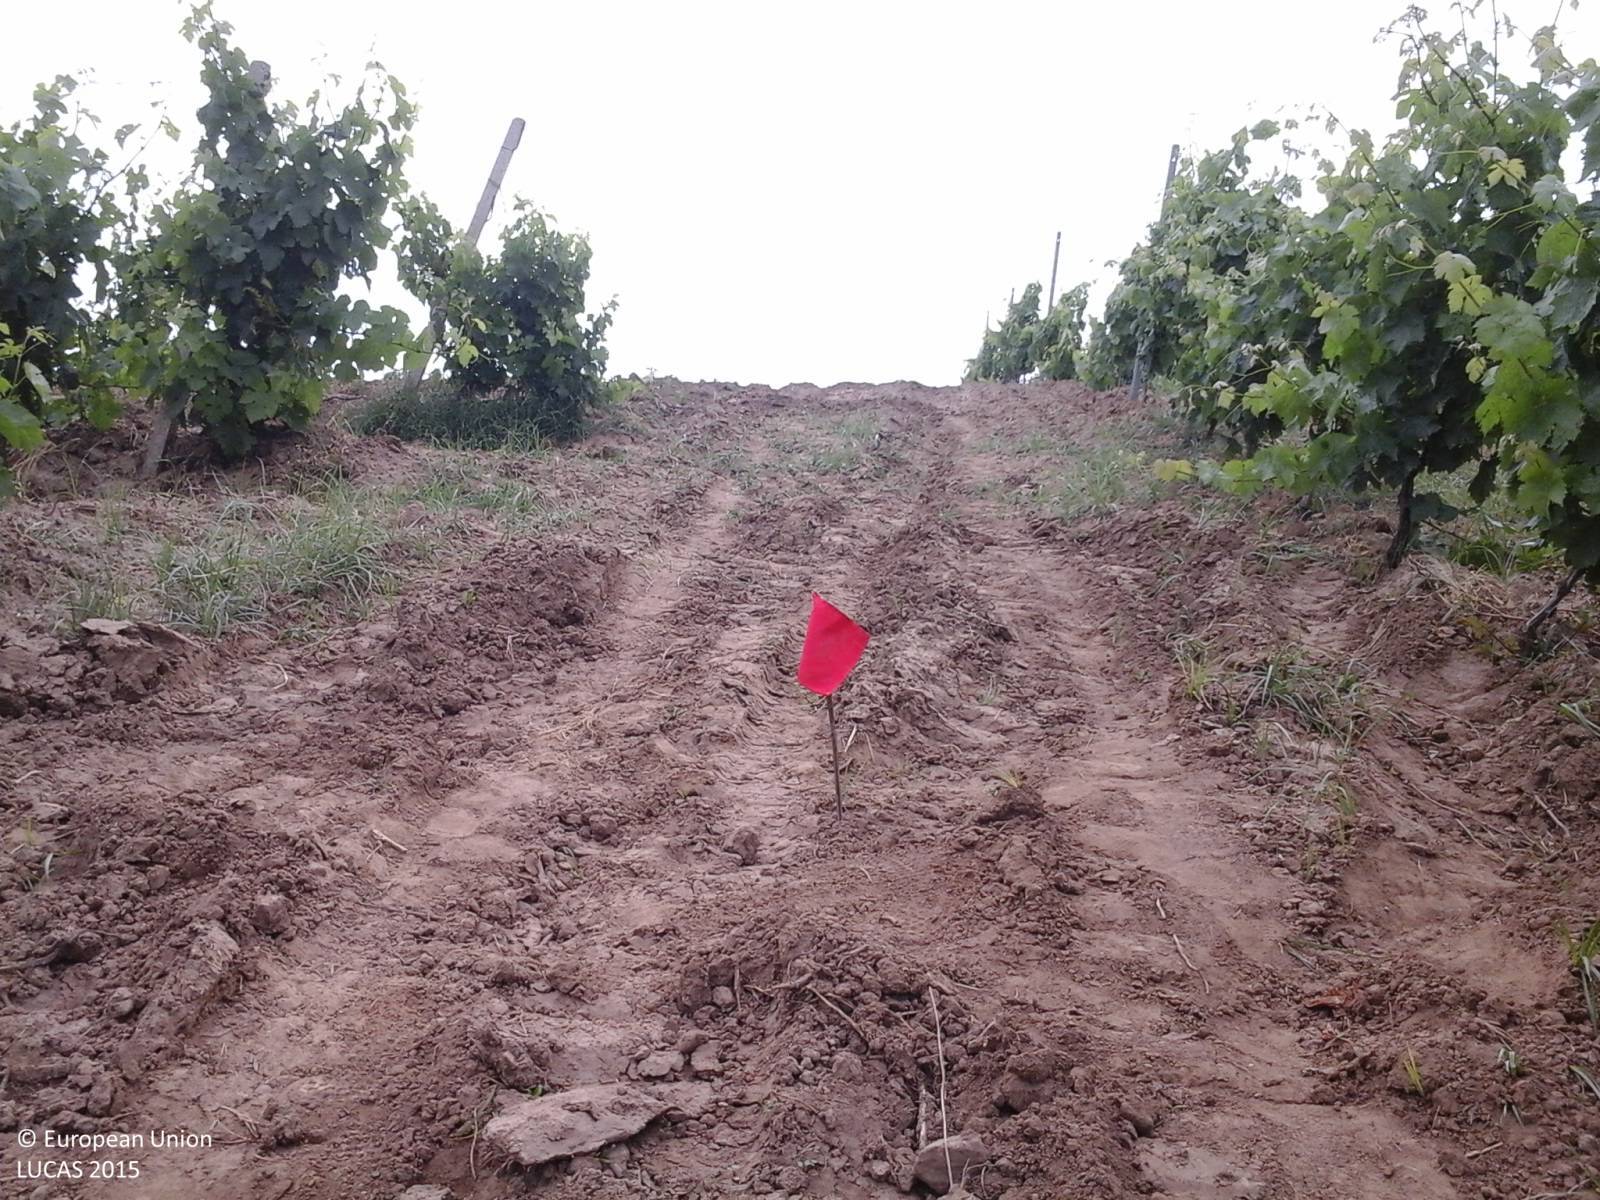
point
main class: Cropland
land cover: Vineyards
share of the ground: 50 - 75 %
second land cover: Other bare soil
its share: > 75 %
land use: Agriculture (excluding fallow land and kitchen gardens)
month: May
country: IT
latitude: 37.9307
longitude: 13.1741
